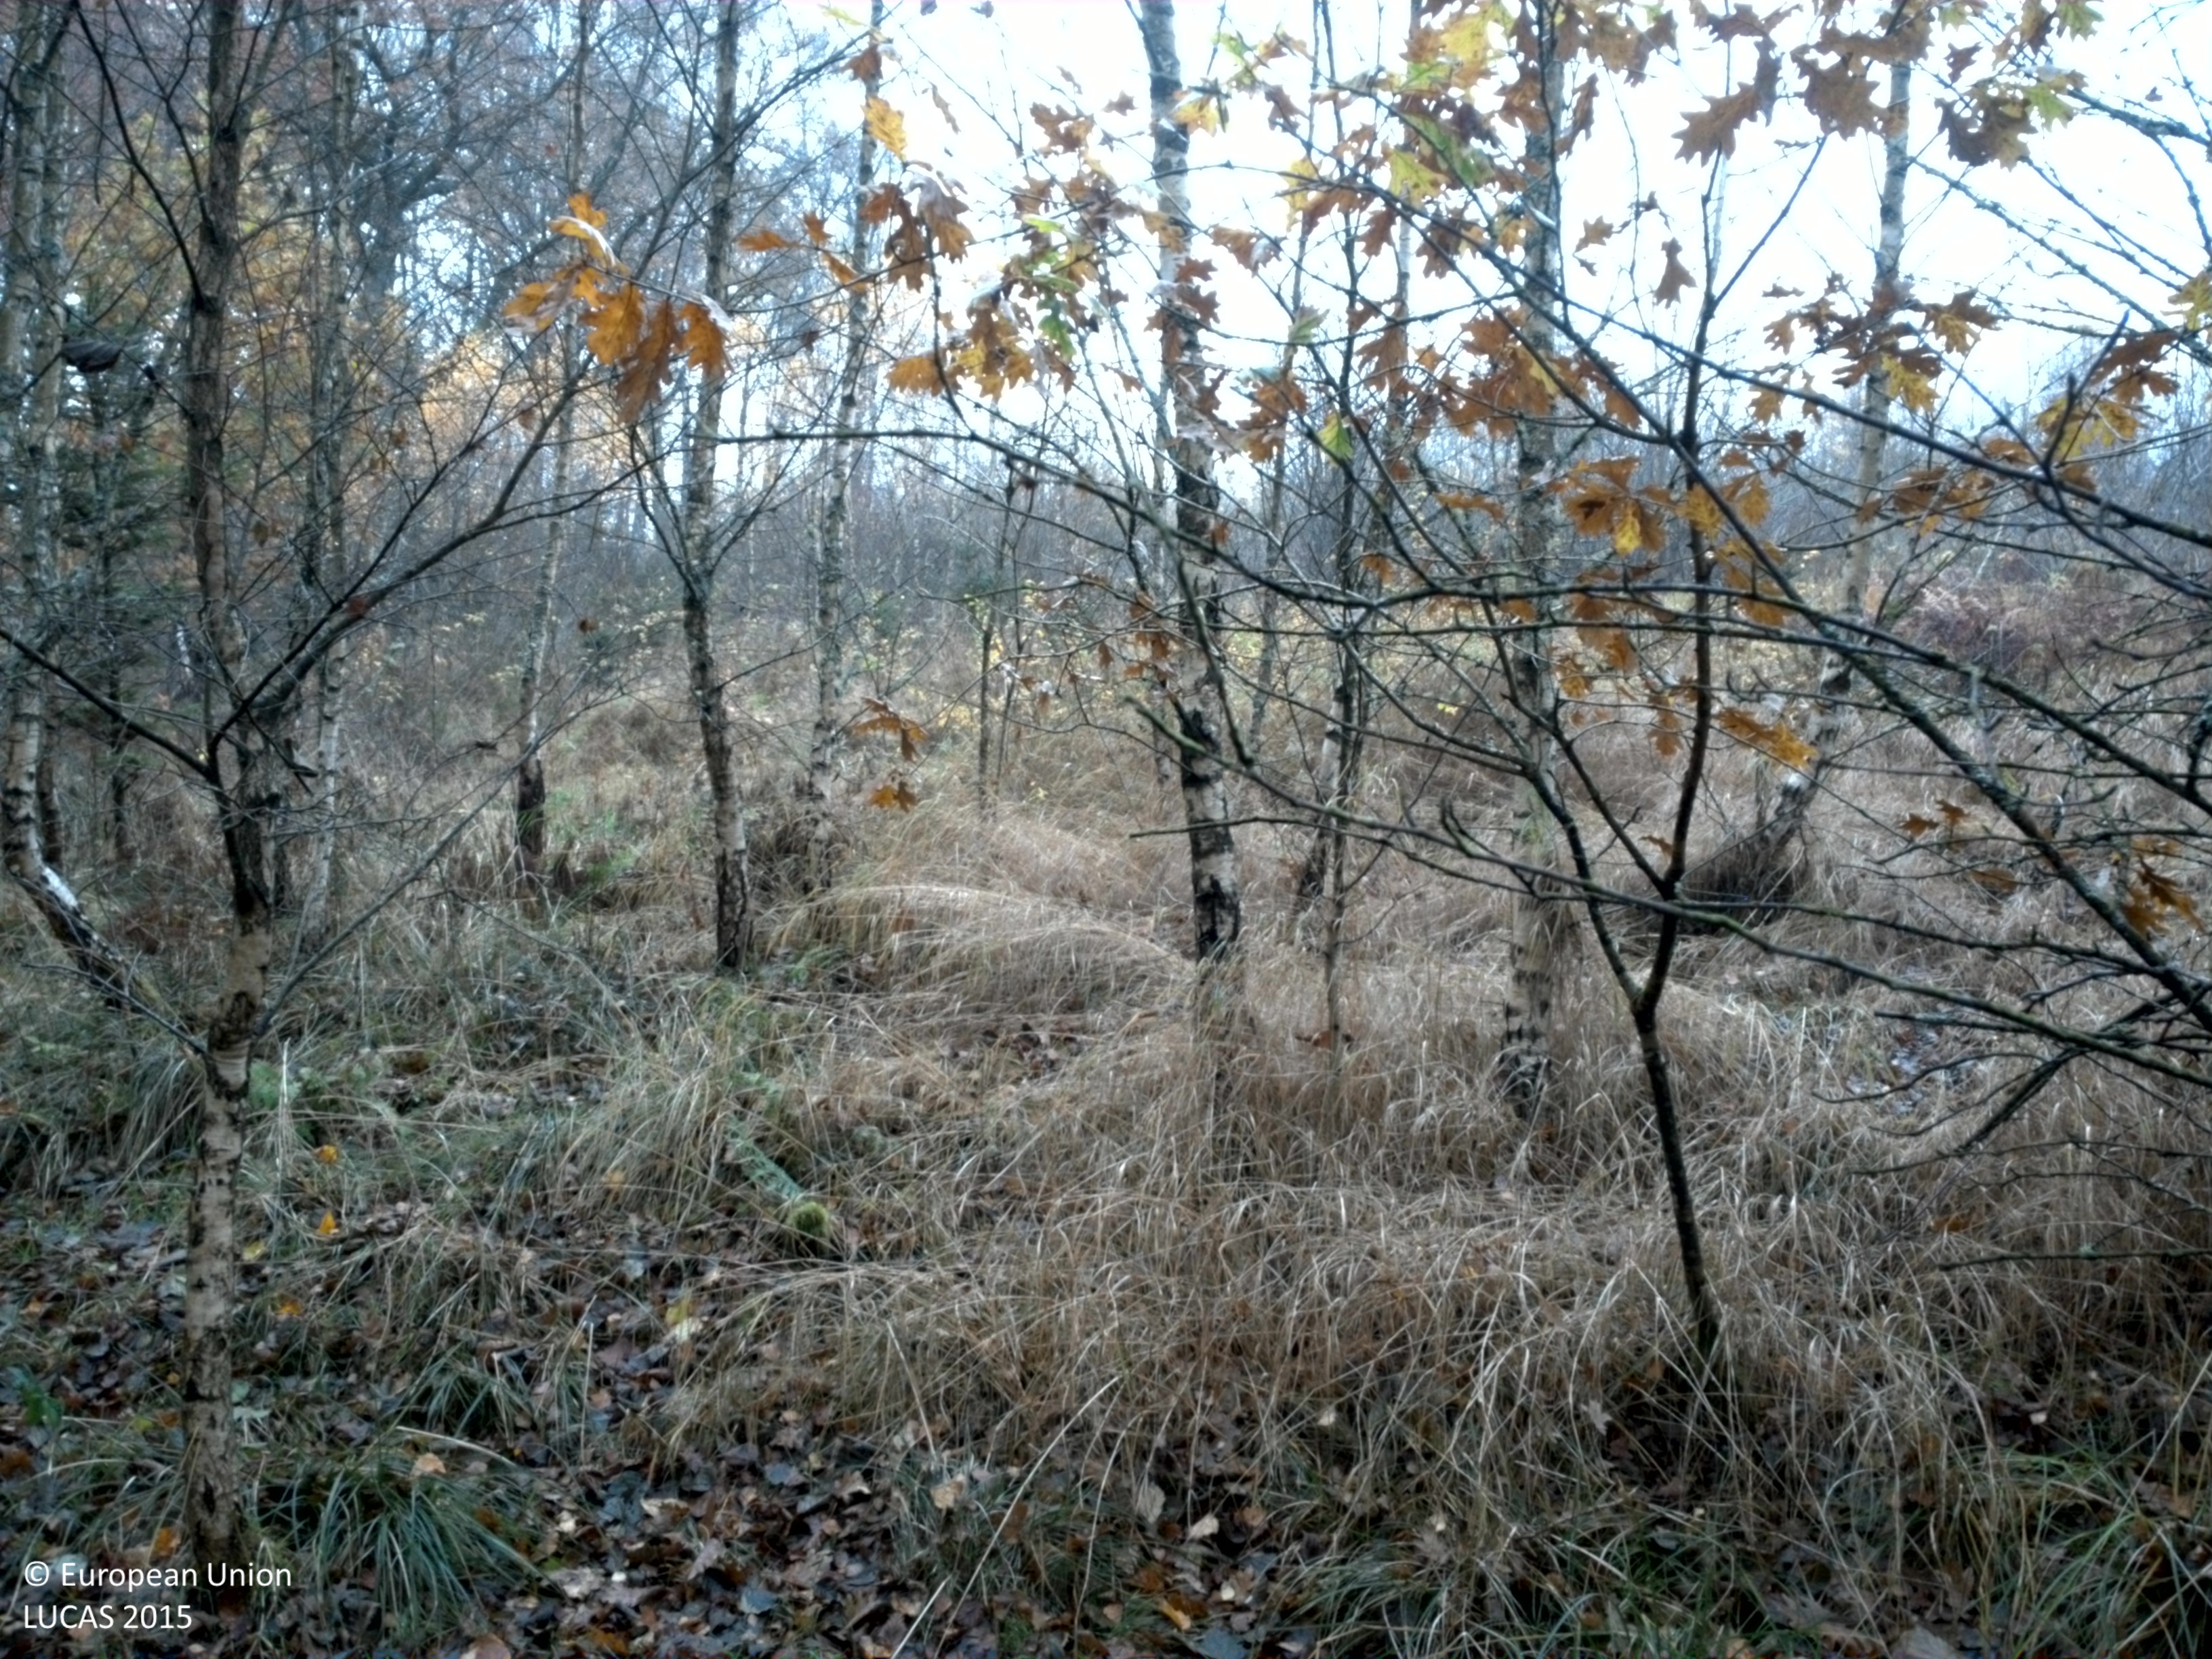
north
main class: Woodland
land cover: Broadleaved woodland
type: mesophytic deciduous forest
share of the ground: 50 - 75 %
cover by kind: broadleaved forest trees 65 %, herbaceous plants 25 %, shrubs 10 %
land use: Forestry
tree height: > 5 m
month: November
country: SE
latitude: 56.1682
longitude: 13.1056
